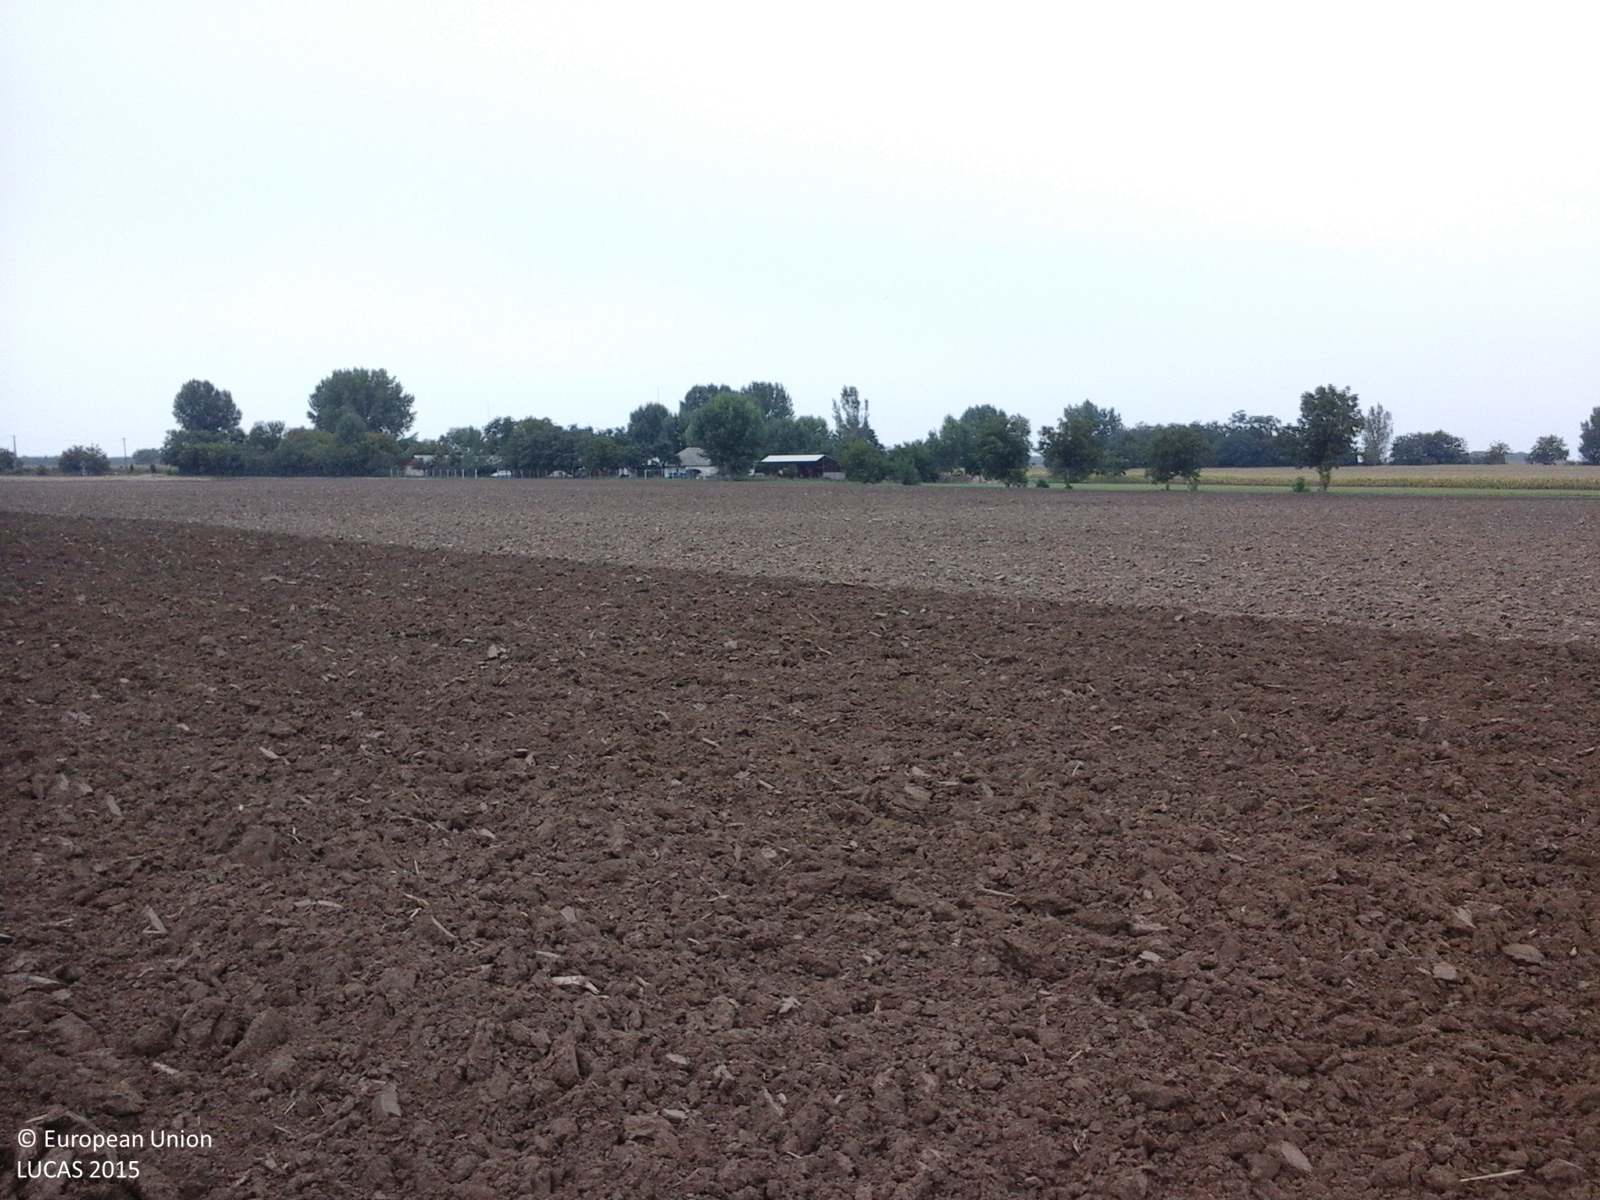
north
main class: Cropland
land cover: Common wheat
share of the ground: < 10 %
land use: Agriculture (excluding fallow land and kitchen gardens)
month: September
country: RO
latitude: 47.4680
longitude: 22.0570
